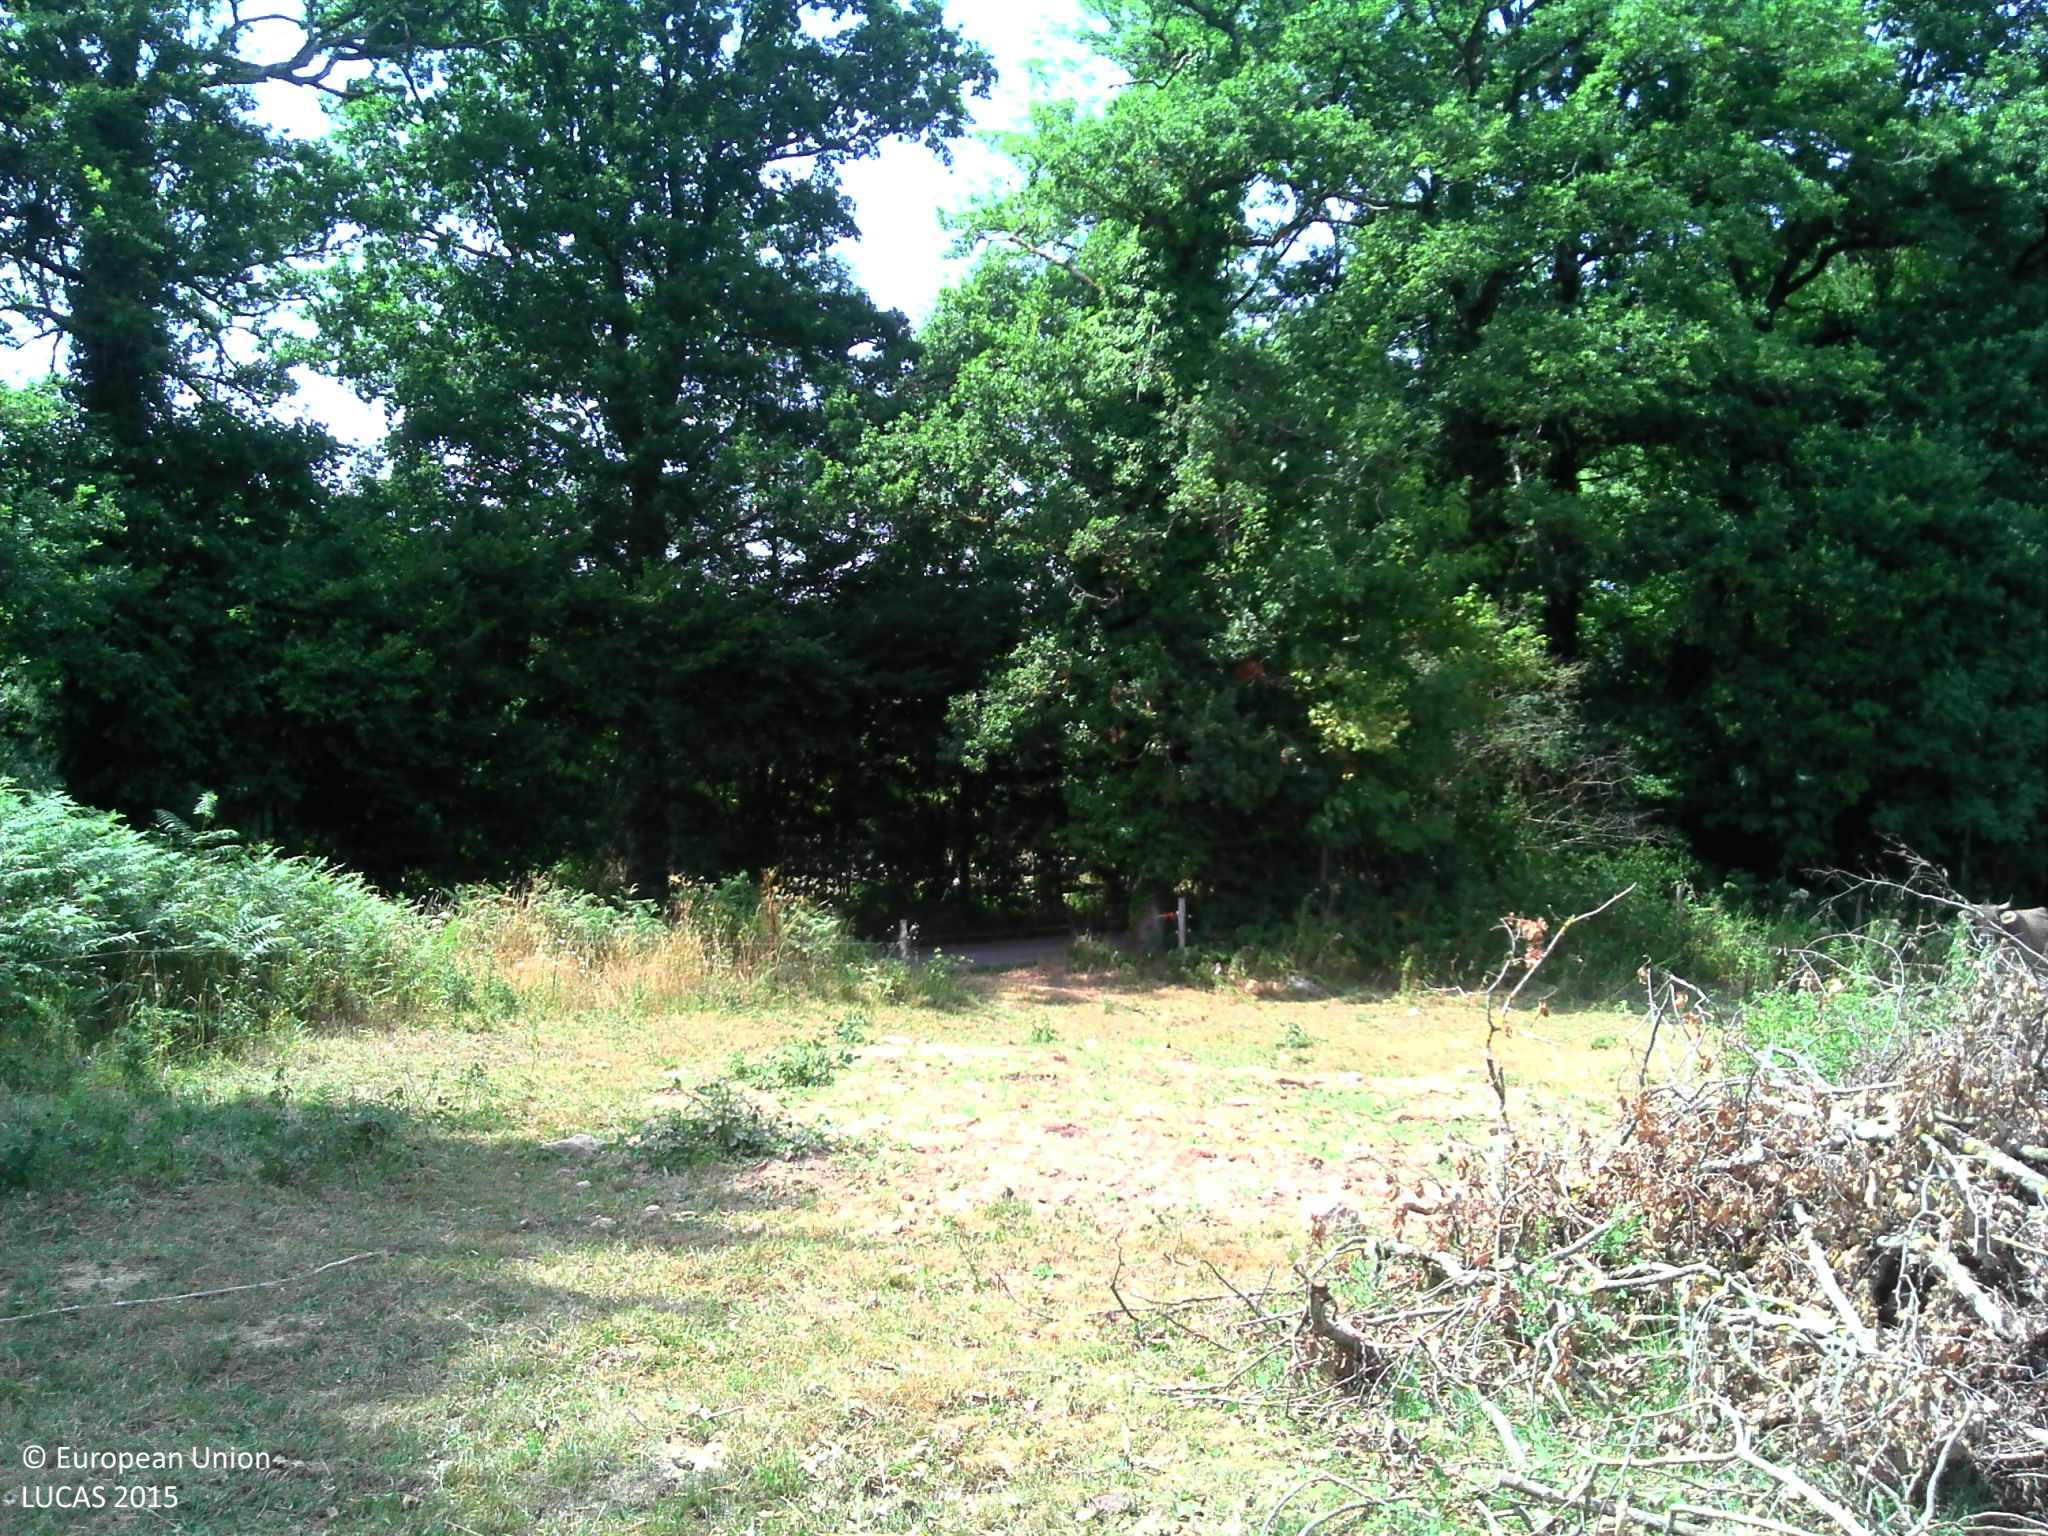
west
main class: Cropland
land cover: Maize
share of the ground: > 75 %
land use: Agriculture (excluding fallow land and kitchen gardens)
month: July
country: FR
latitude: 45.7204
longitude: 1.0348
